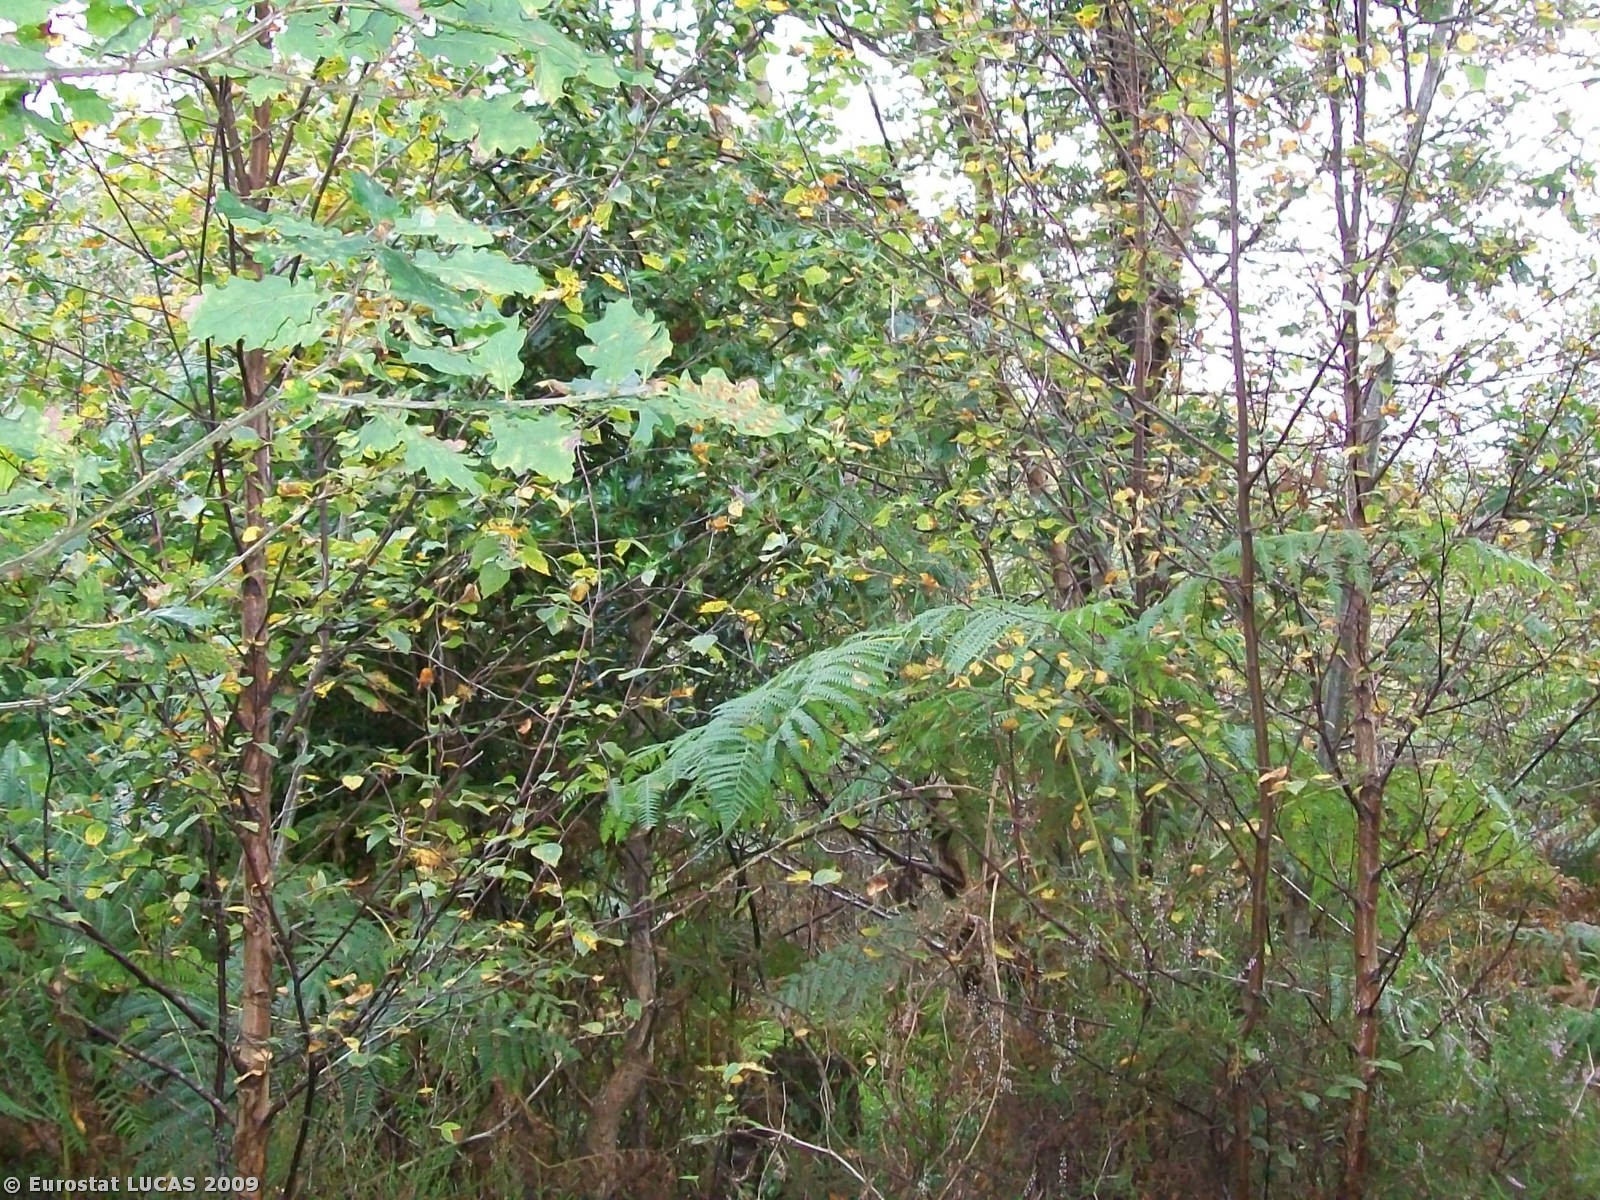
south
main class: Woodland
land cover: Broadleaved woodland
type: acidophilous oak and oak-birch forest
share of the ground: > 75 %
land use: Forestry
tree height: > 5 m
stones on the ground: < 10 %
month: September
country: IE
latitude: 53.0664
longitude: -8.3811
